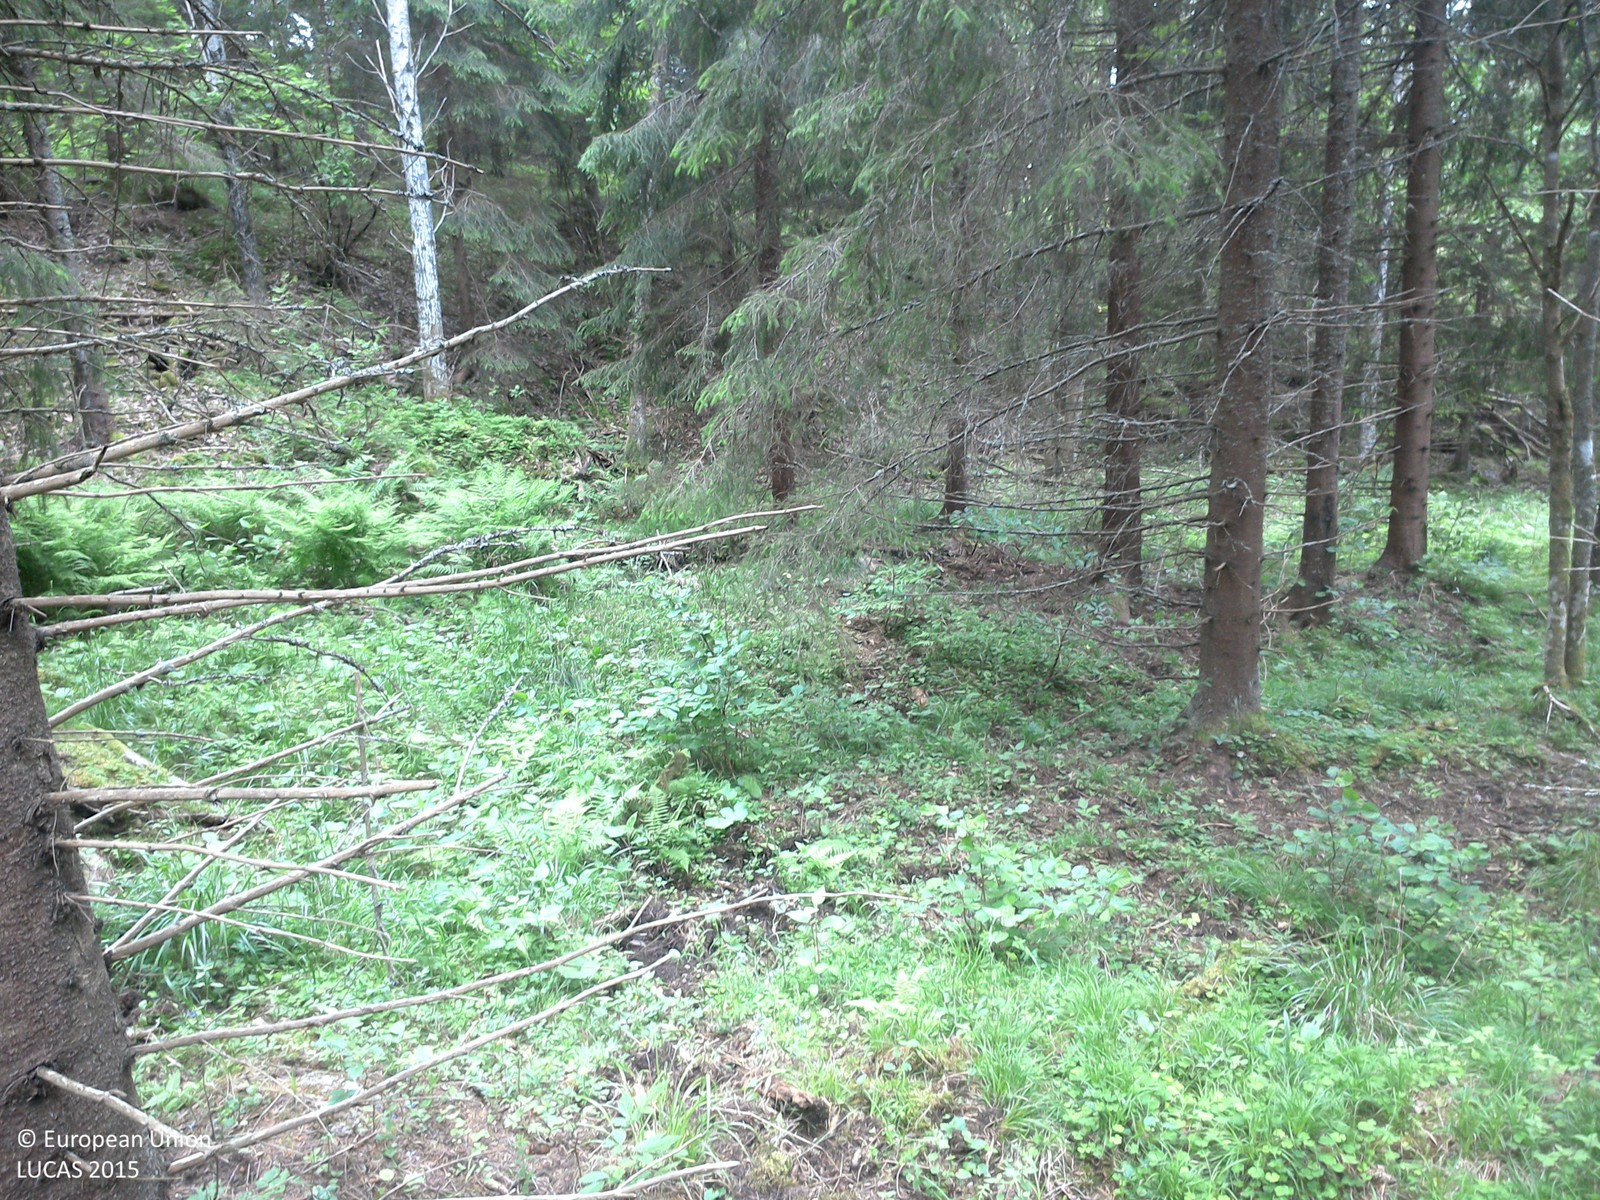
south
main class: Woodland
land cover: Spruce dominated coniferous woodland
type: boreal forest
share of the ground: 50 - 75 %
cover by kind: coniferous forest trees 60 %, lichens and mosses 40 %
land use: Forestry
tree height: > 5 m
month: June
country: SE
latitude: 58.0914
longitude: 15.4402
